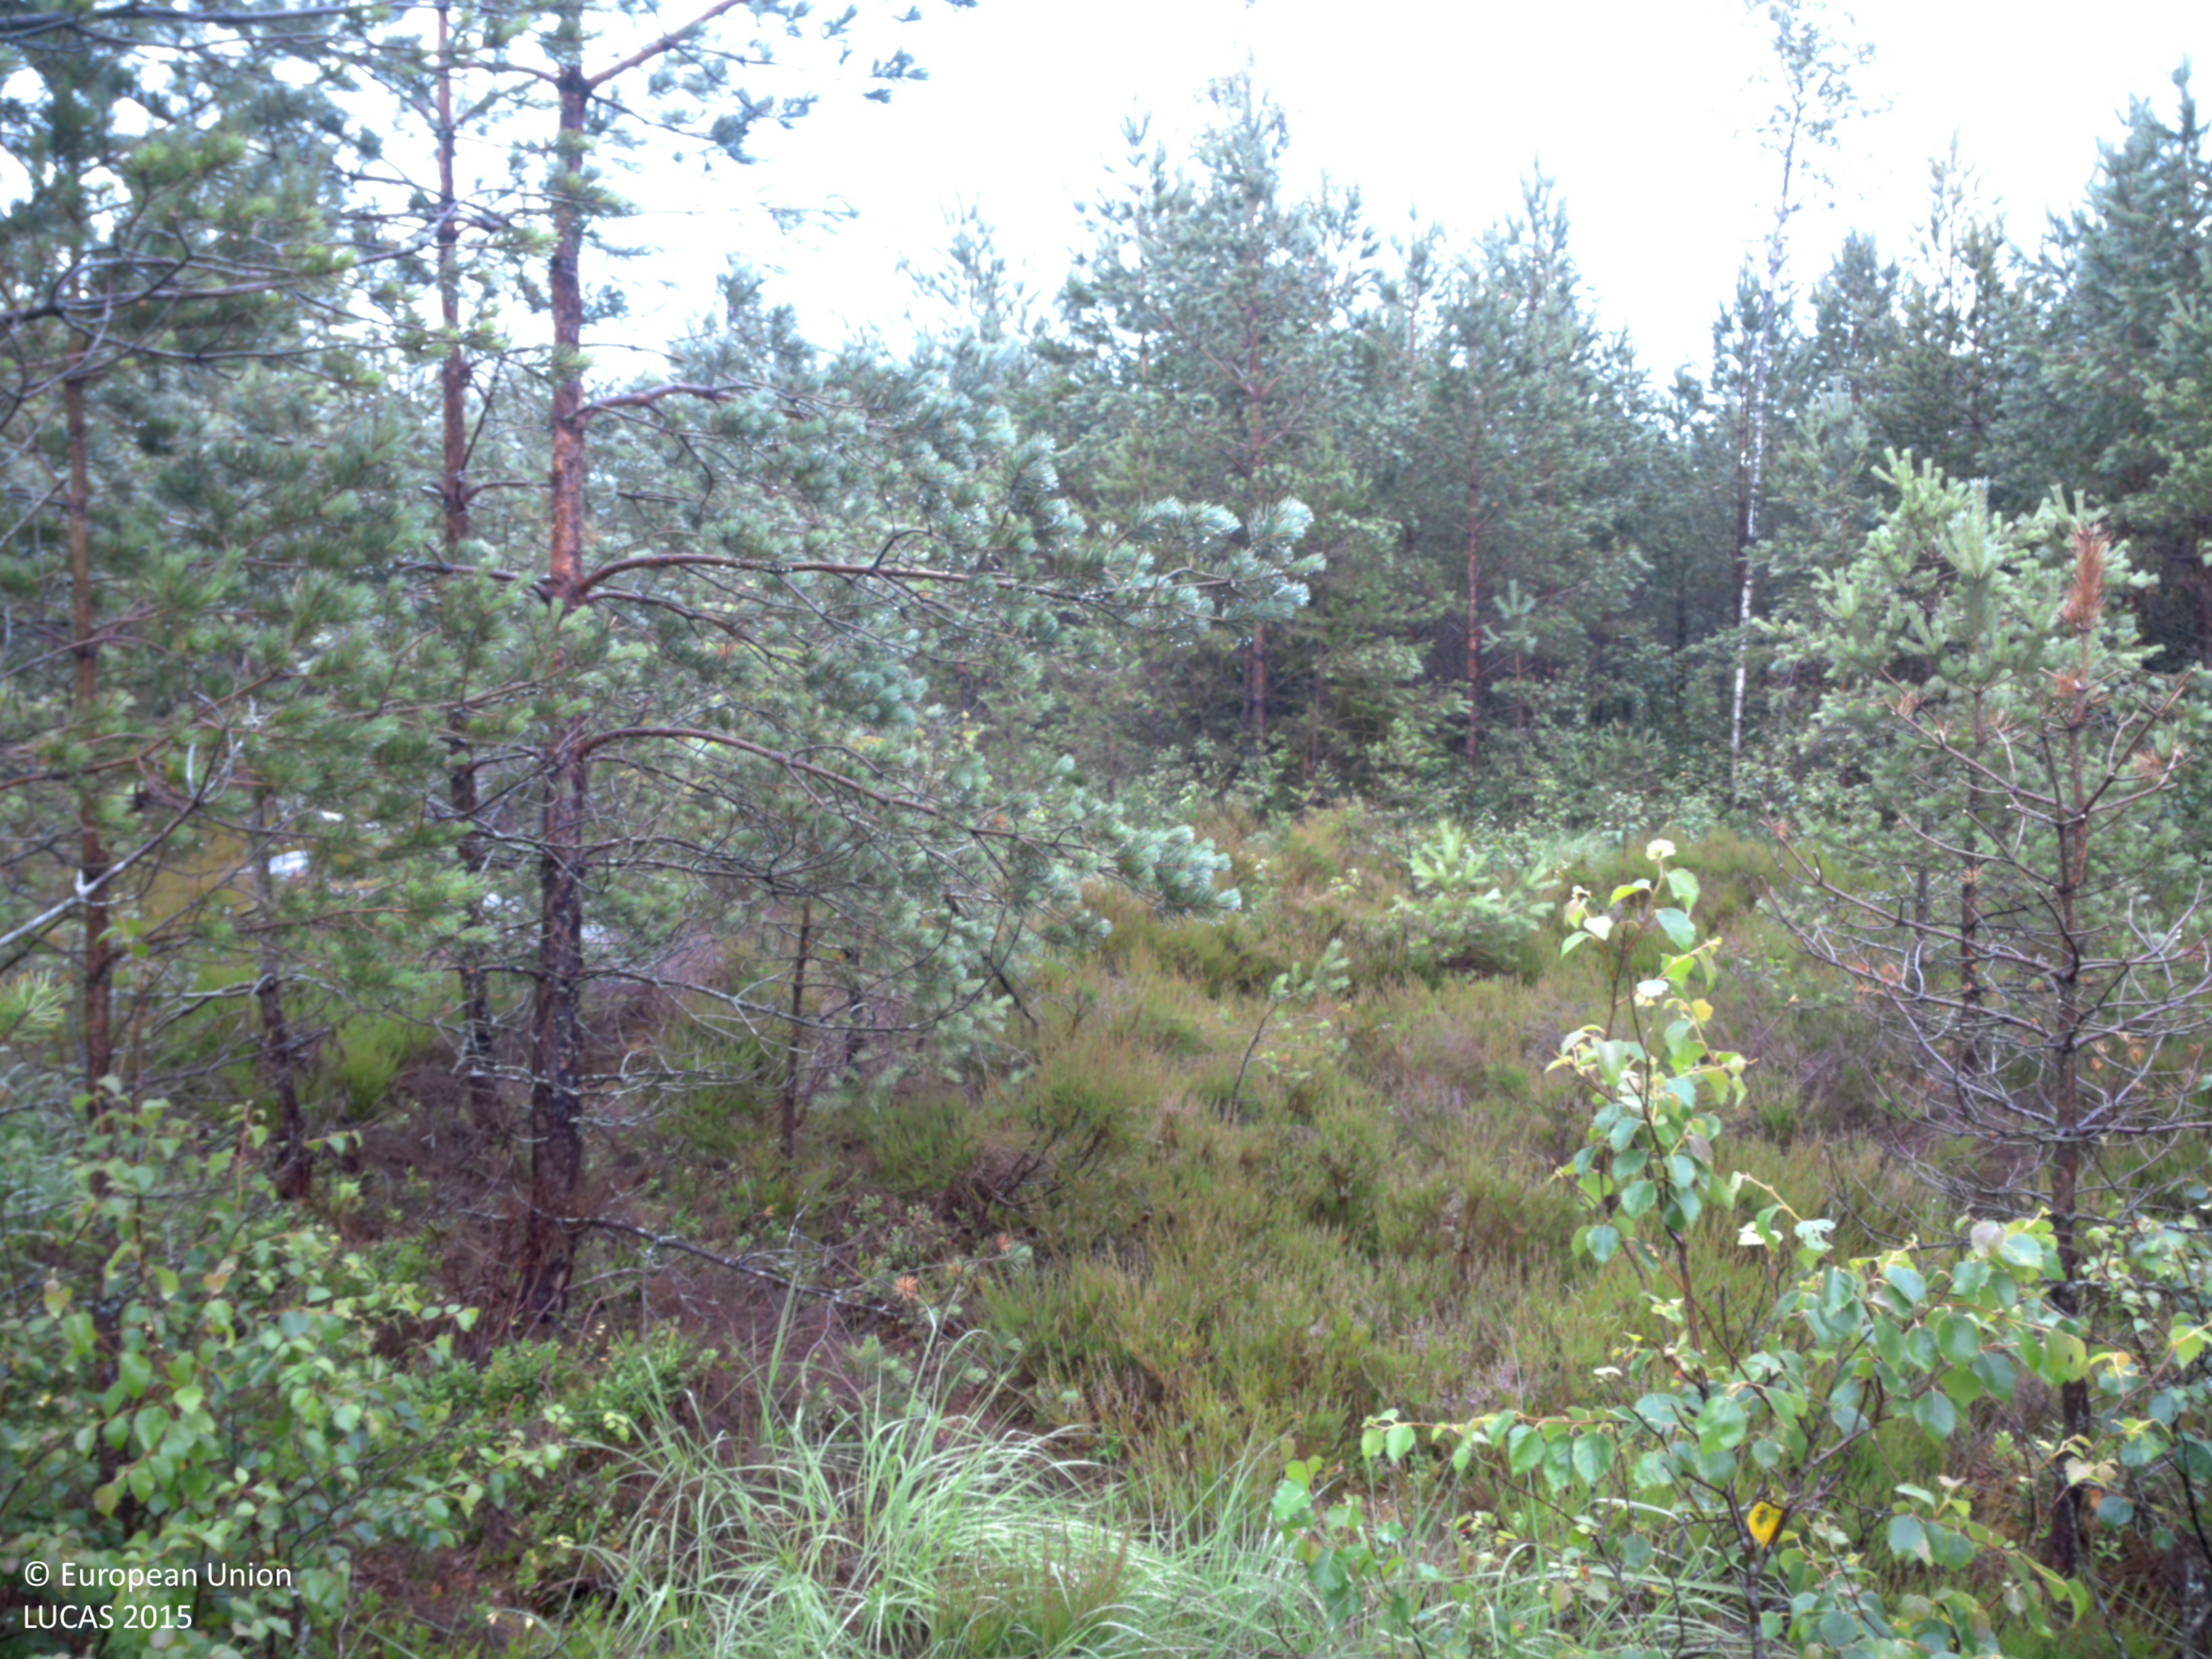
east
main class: Woodland
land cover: Pine dominated mixed woodland
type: boreal forest
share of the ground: 50 - 75 %
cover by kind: coniferous forest trees 40 %, herbaceous plants 30 %, broadleaved forest trees 15 %, shrubs 15 %
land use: Forestry
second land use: Amenities, museums, leisure
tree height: < 5 m
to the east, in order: Pine dominated mixed woodland; Pine dominated coniferous woodland
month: July
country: SE
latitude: 58.6944
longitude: 11.7044
